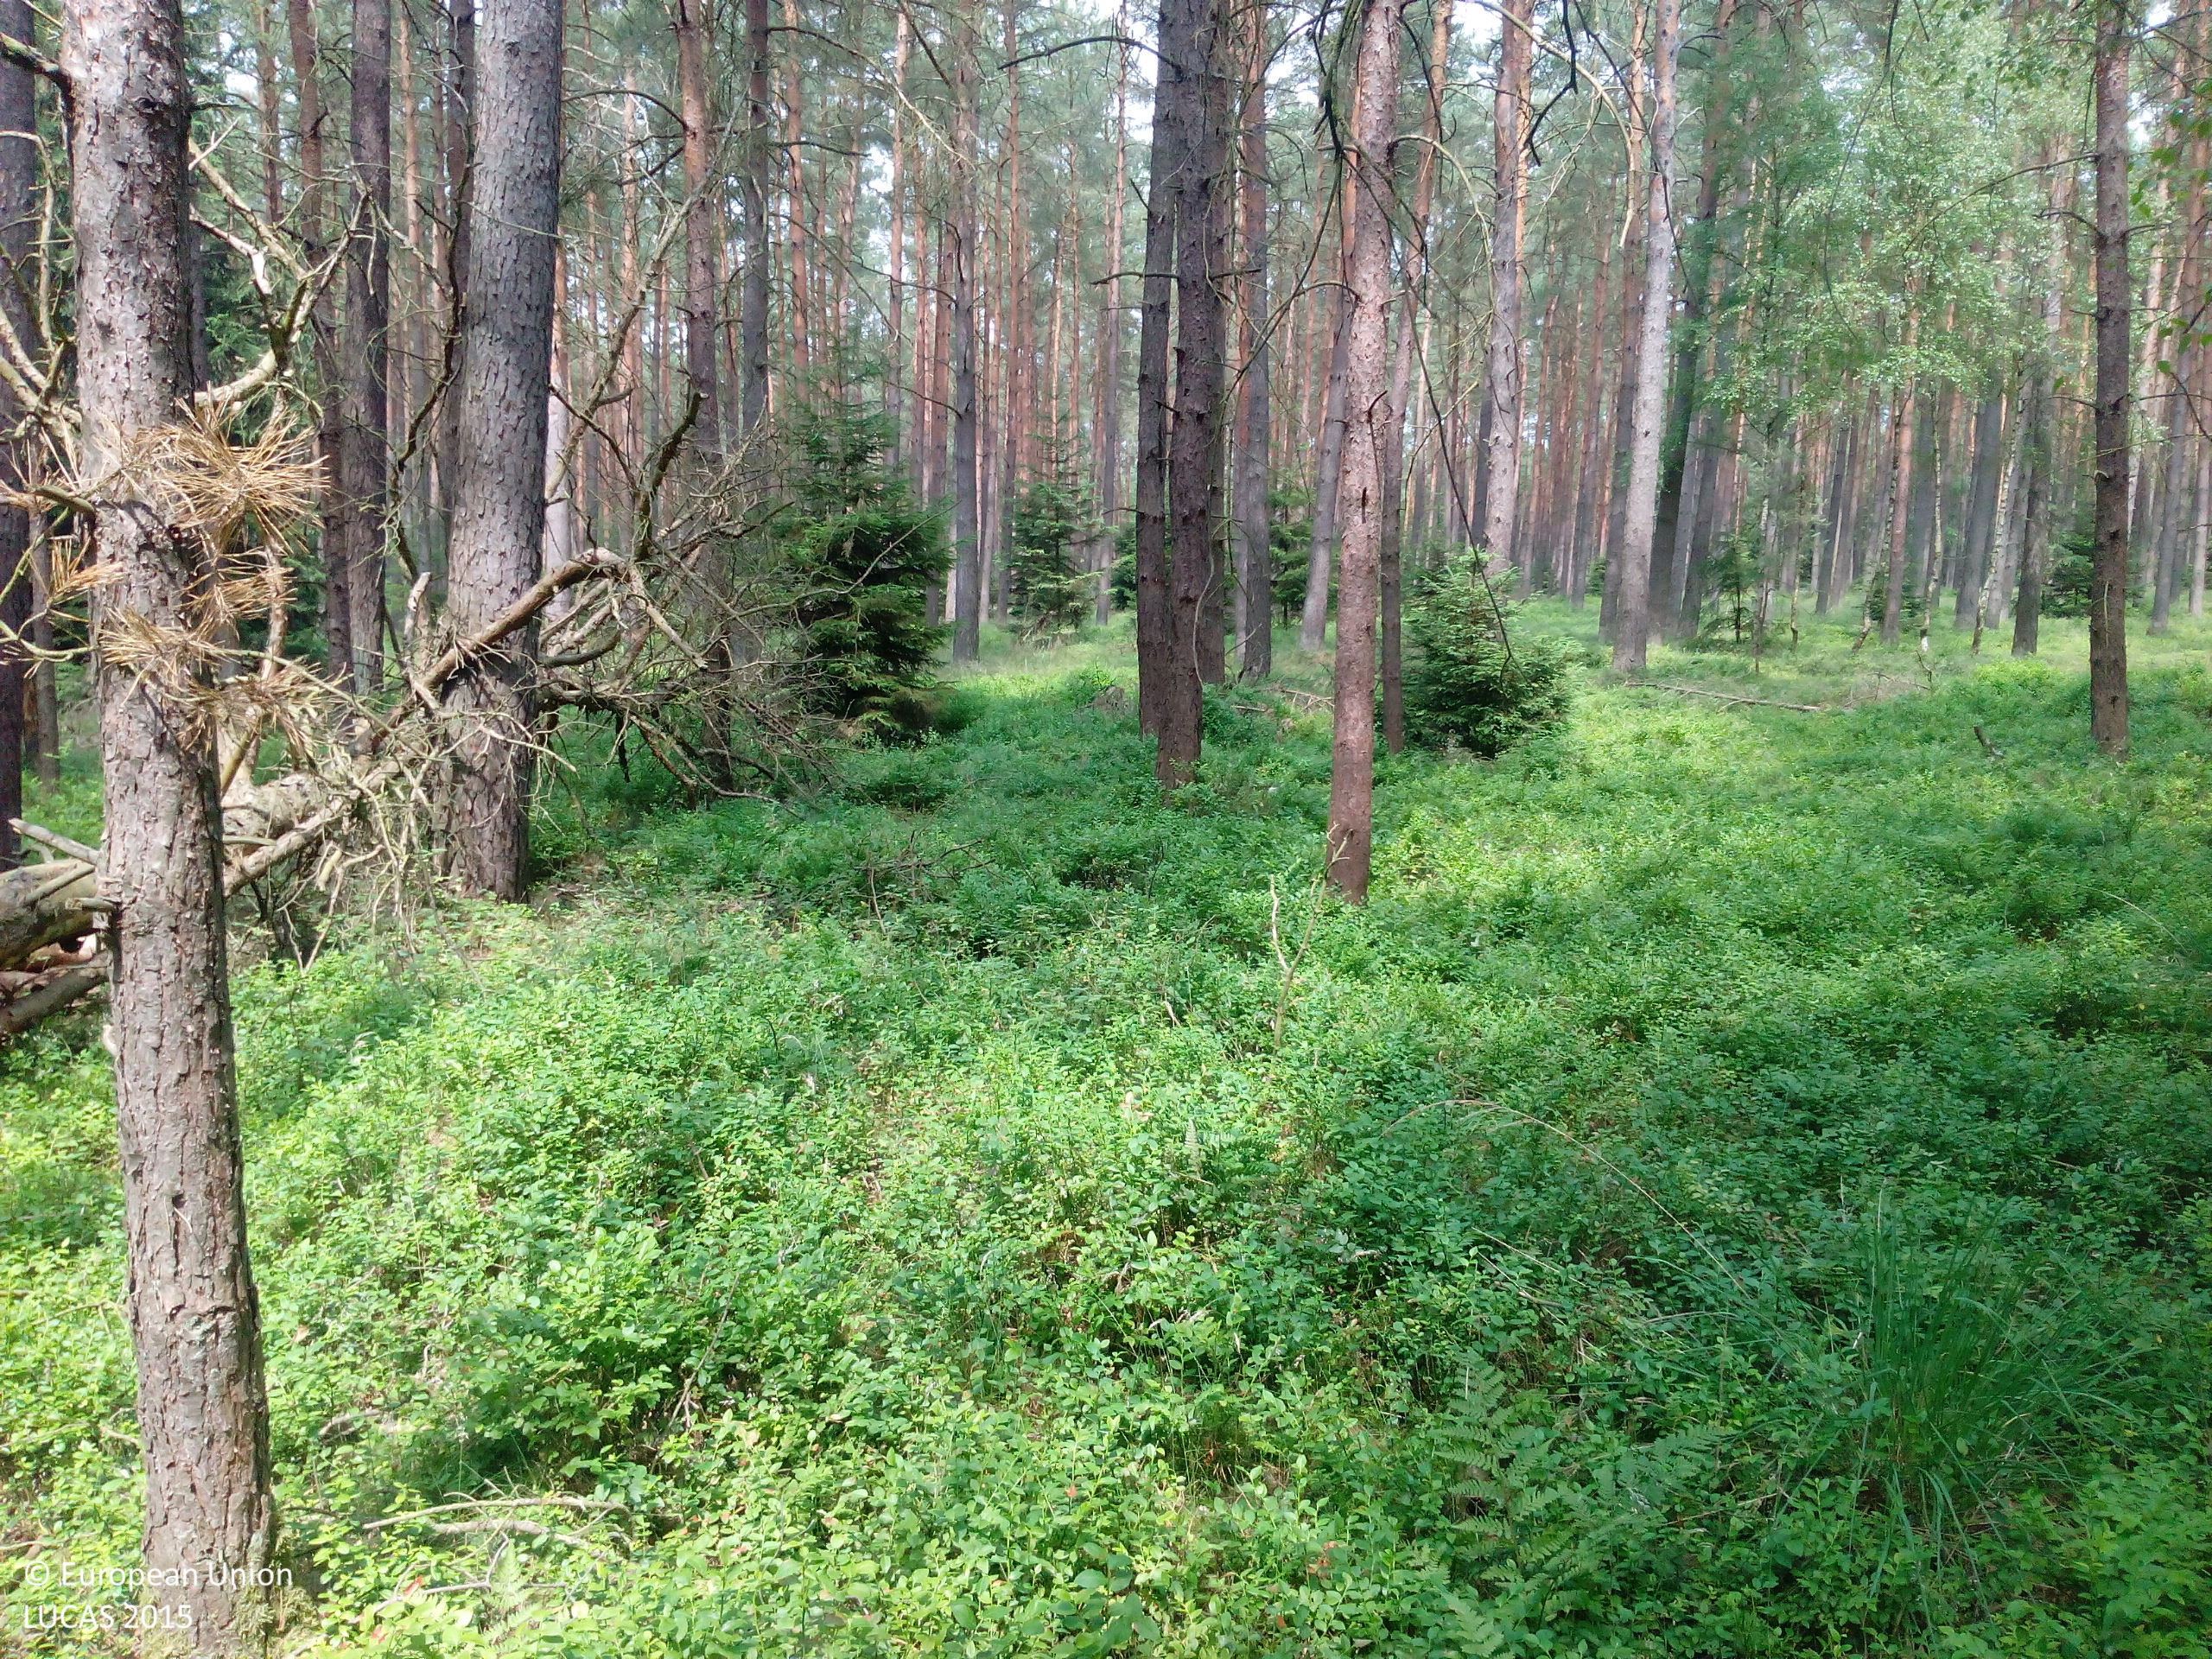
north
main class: Woodland
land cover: Pine dominated coniferous woodland
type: hemiboreal forest and nemoral coniferous forest and mixed broadleaved-coniferous forest
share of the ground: > 75 %
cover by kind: coniferous forest trees 75 %, broadleaved forest trees 15 %, shrubs 10 %
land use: Forestry
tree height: > 5 m
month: July
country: DE
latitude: 52.7546
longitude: 10.2814
